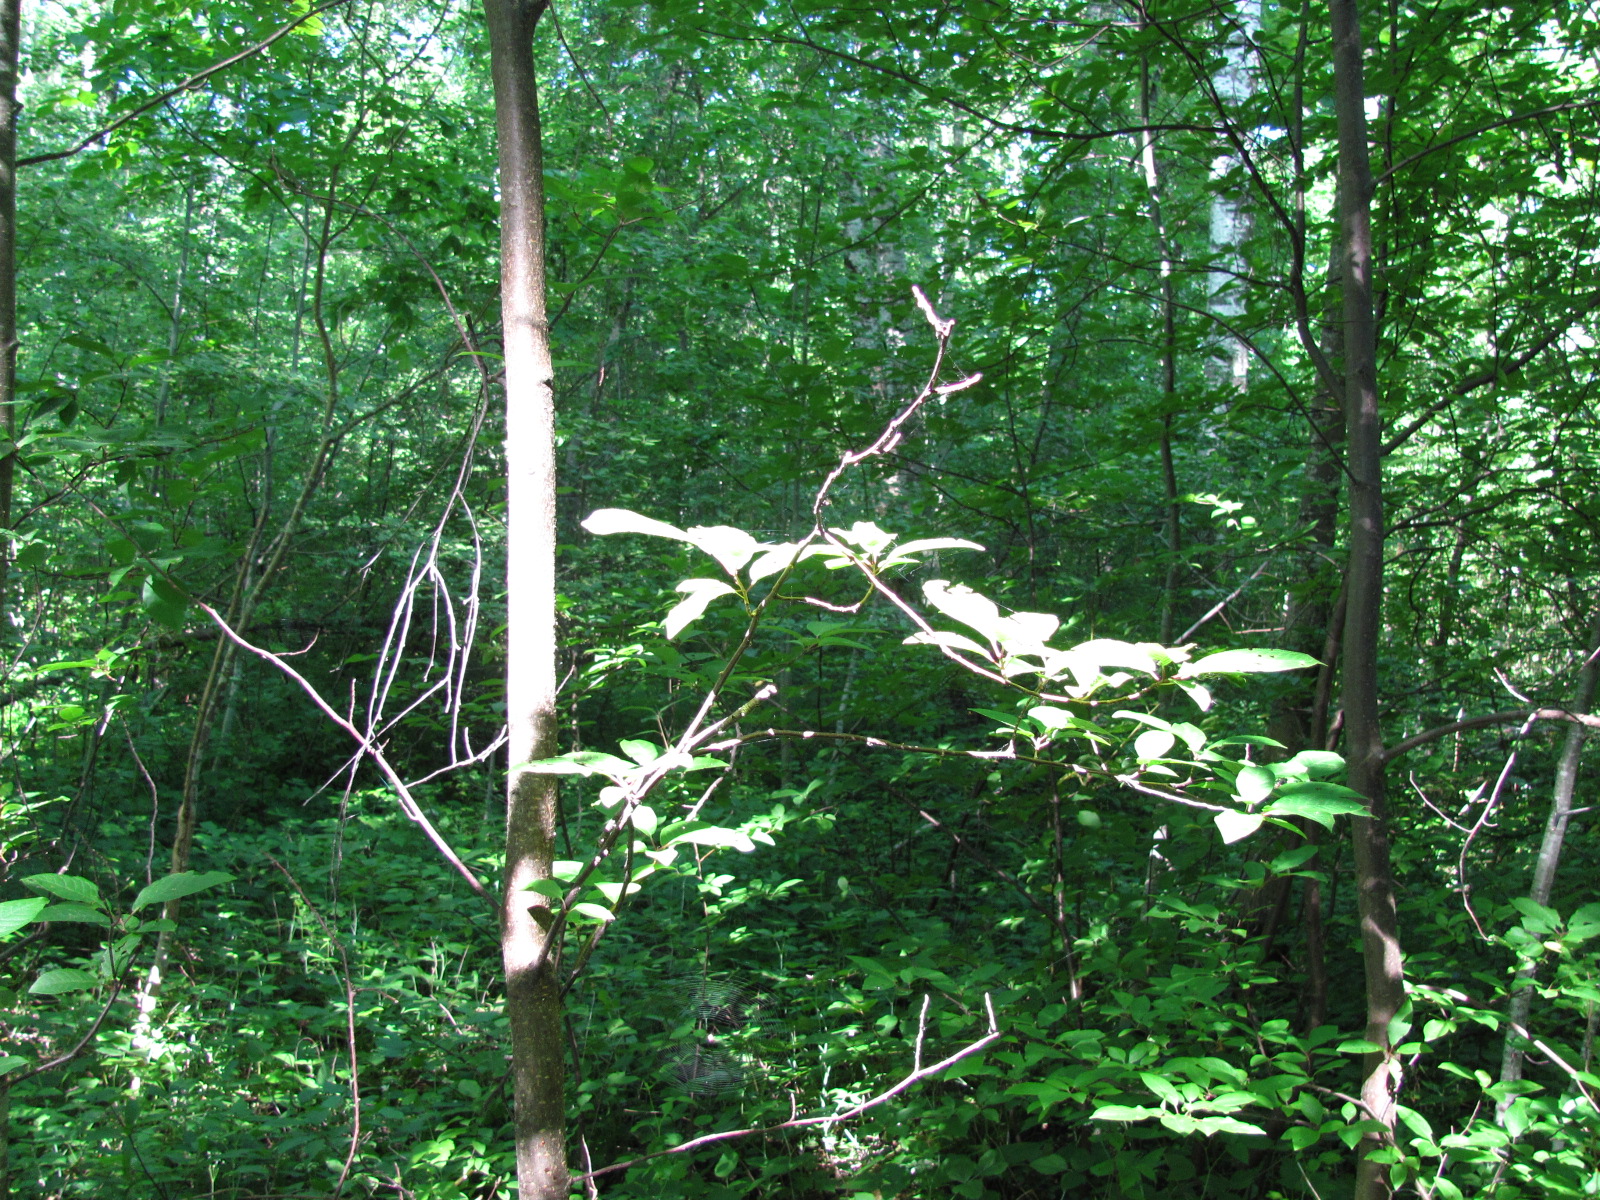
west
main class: Woodland
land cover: Broadleaved woodland
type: non-riverine alder, birch or aspen forest
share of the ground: > 75 %
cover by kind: broadleaved forest trees 100 %
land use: Forestry
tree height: > 5 m
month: June
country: LV
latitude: 56.3526
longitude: 23.9532
